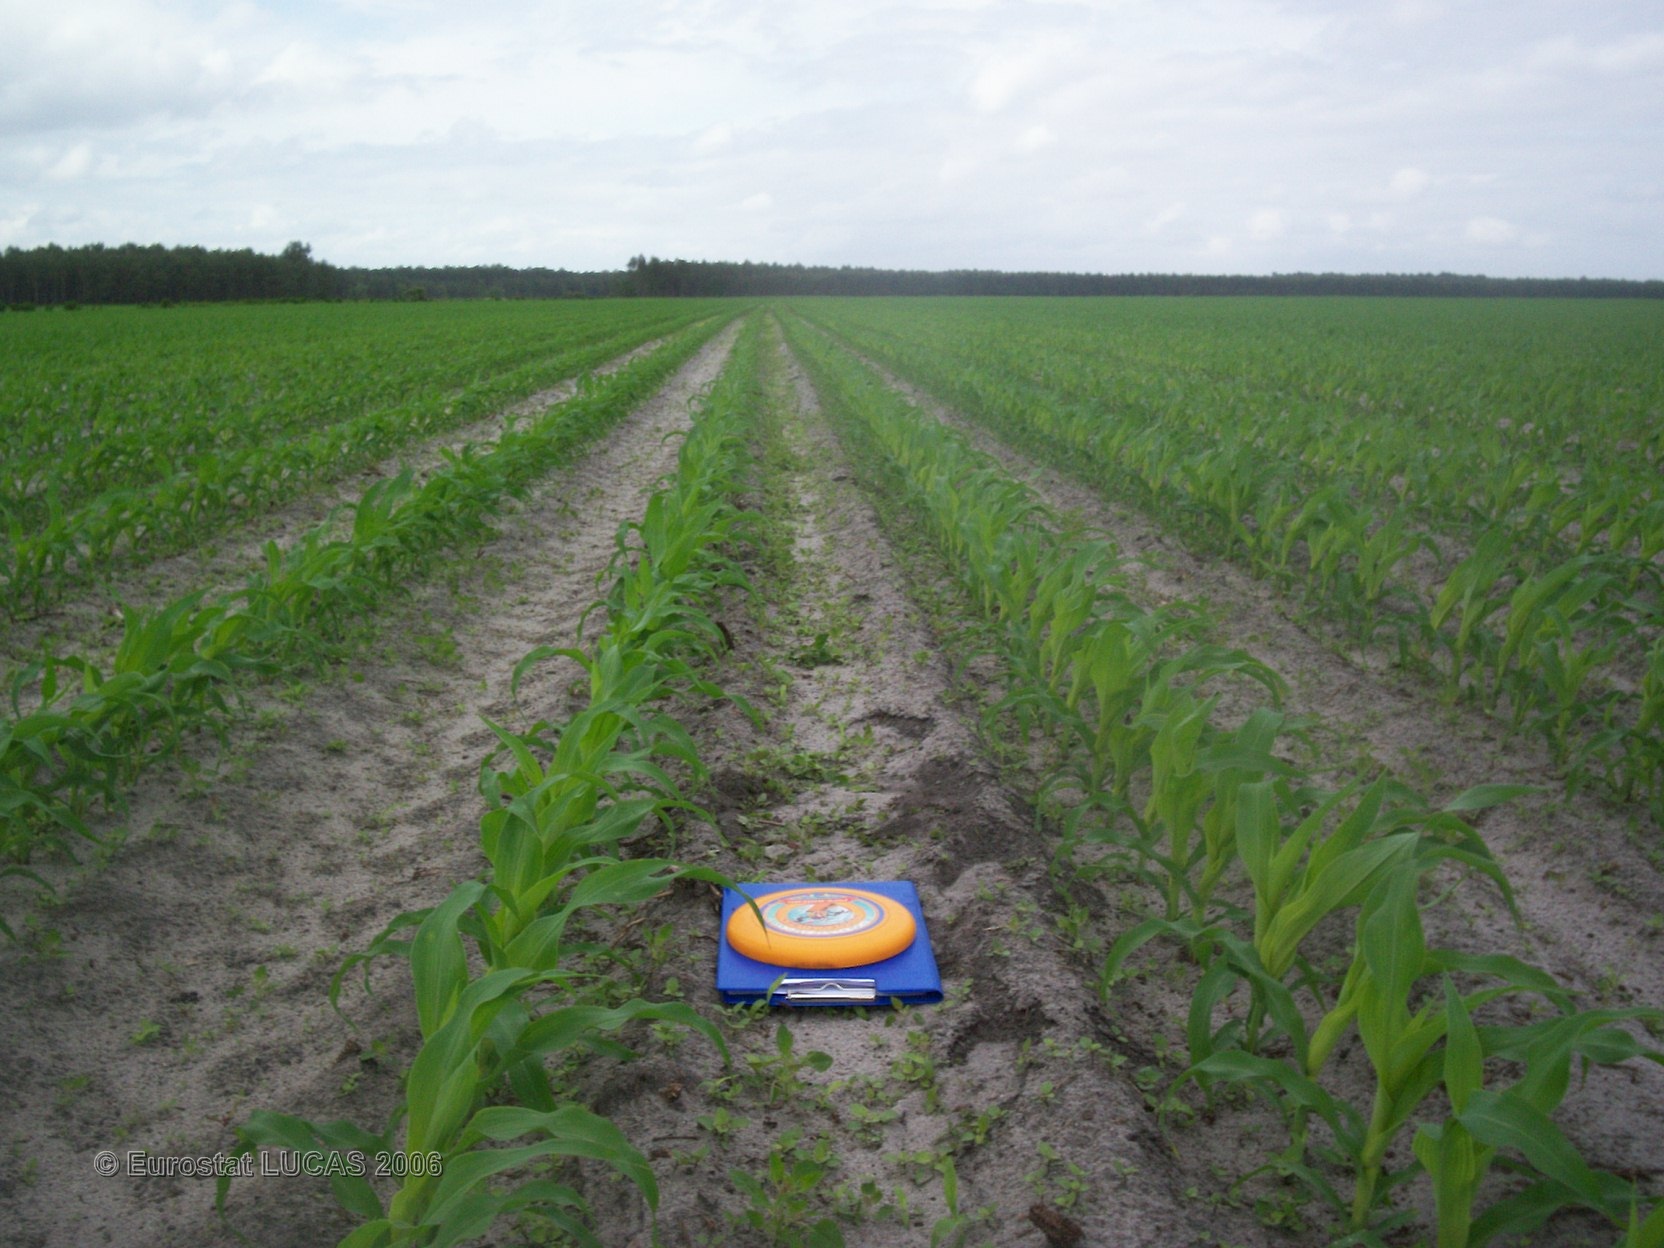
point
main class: Cropland
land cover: Maize
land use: Agriculture (excluding fallow land and kitchen gardens)
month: May
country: FR
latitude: 44.3803
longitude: -0.4953
